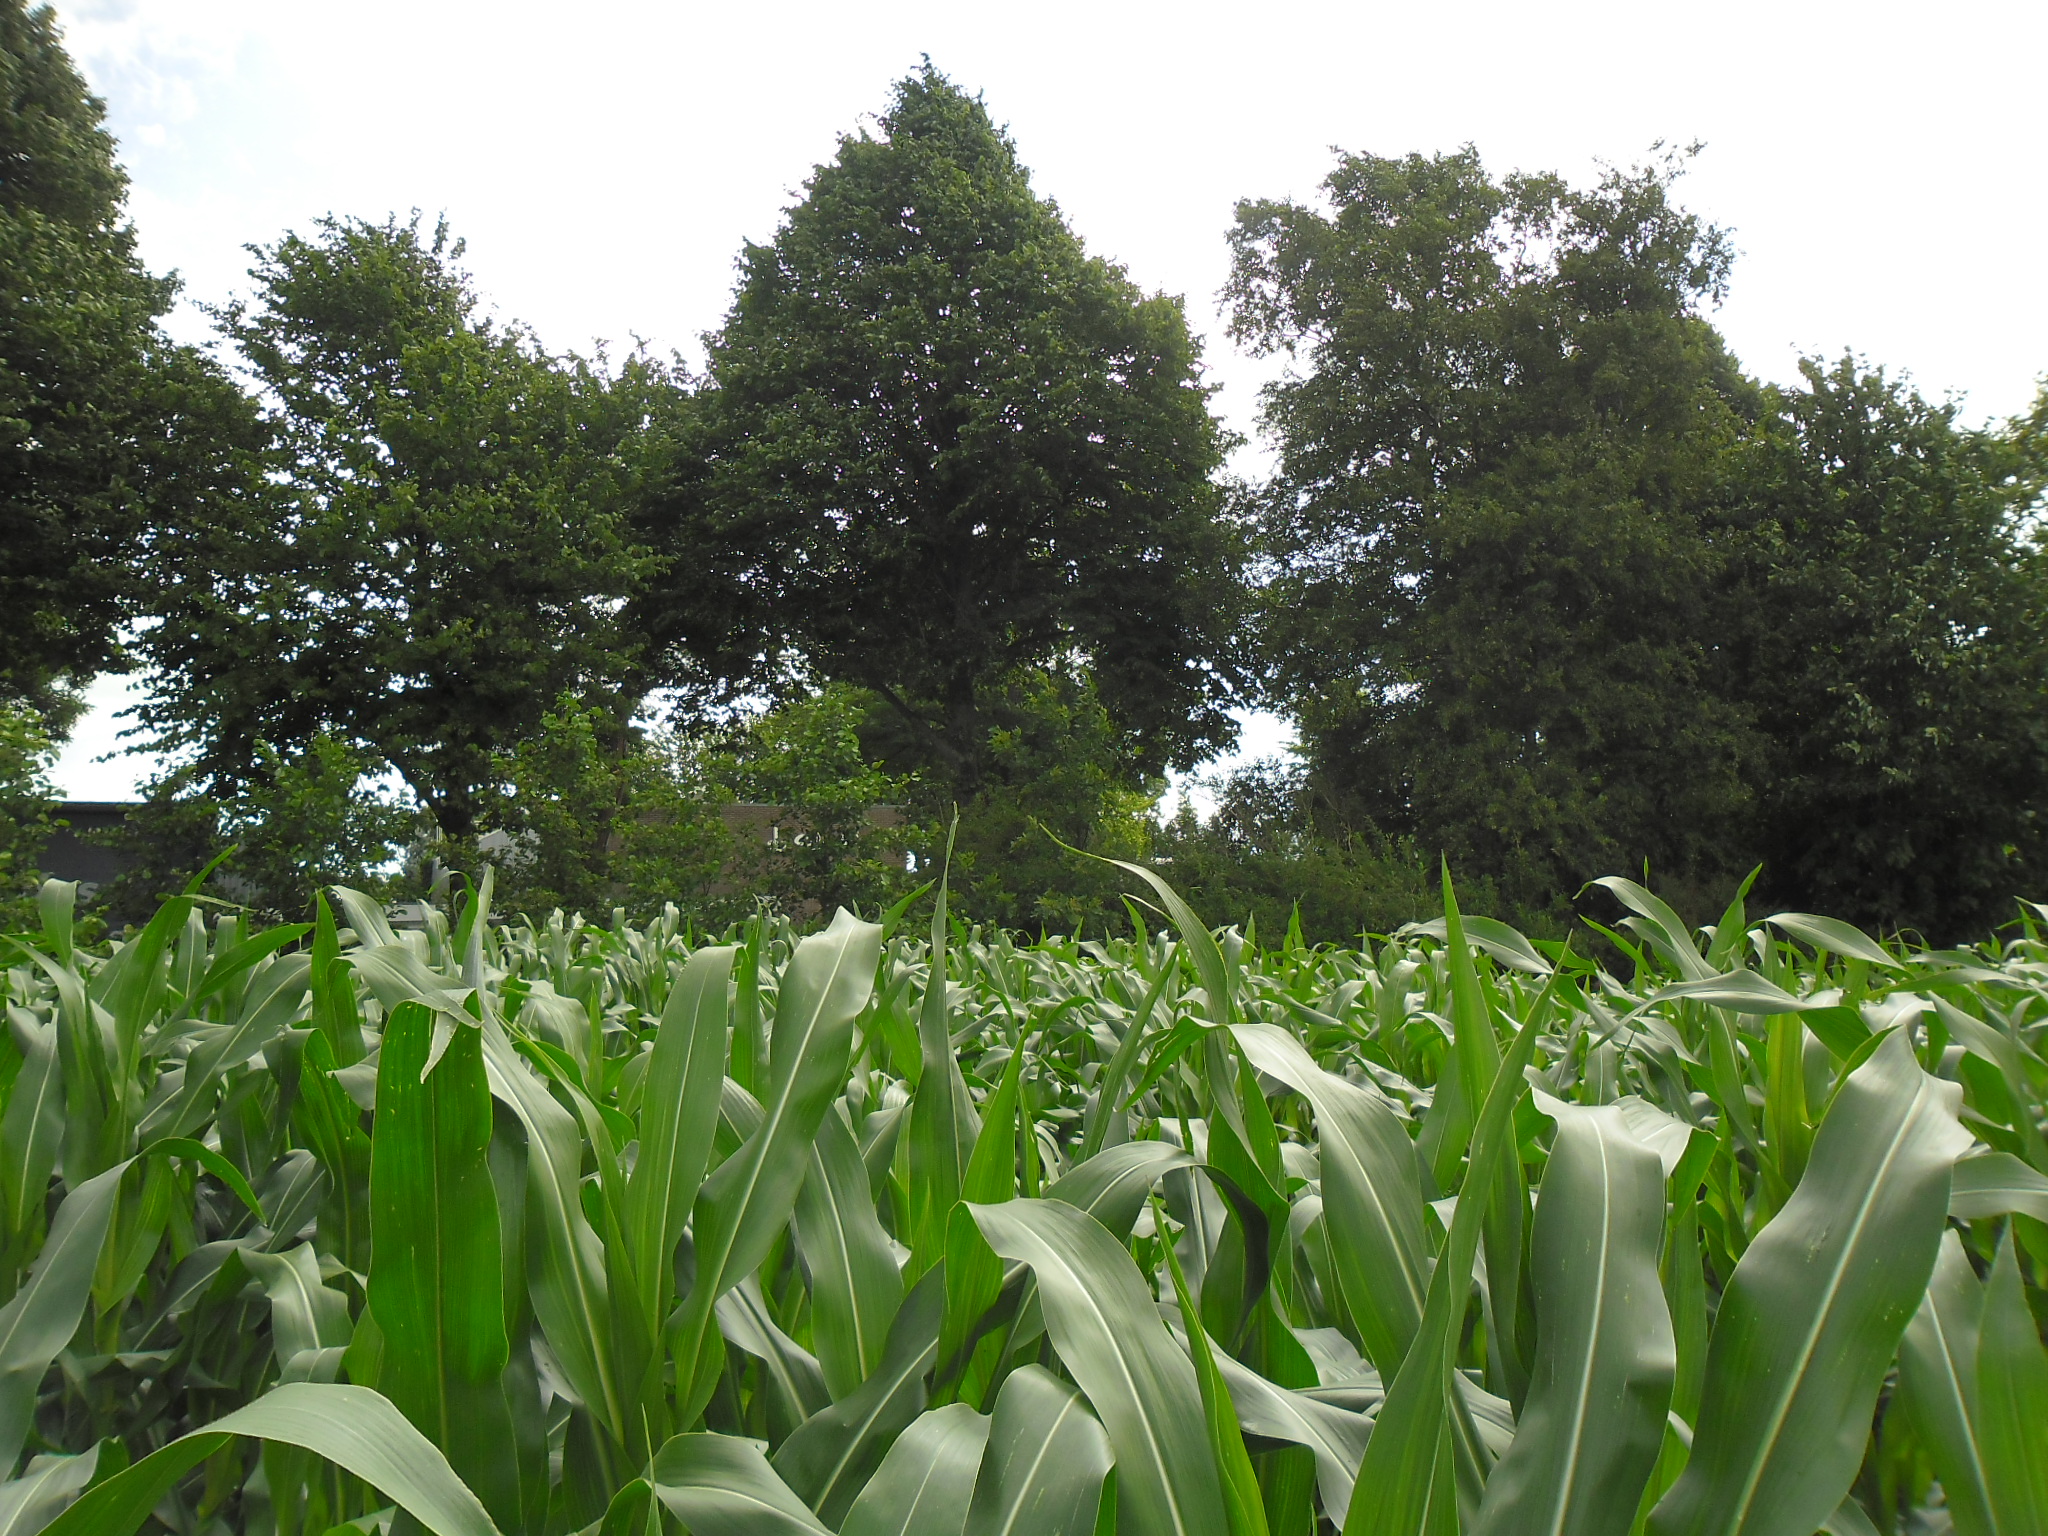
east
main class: Cropland
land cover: Maize
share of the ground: > 75 %
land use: Agriculture (excluding fallow land and kitchen gardens)
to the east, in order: Maize; Shrubland without tree cover; Lines of trees; Artificial constructions in urban areas; Inland fresh running water
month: July
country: NL
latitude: 52.7294
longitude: 6.1642
